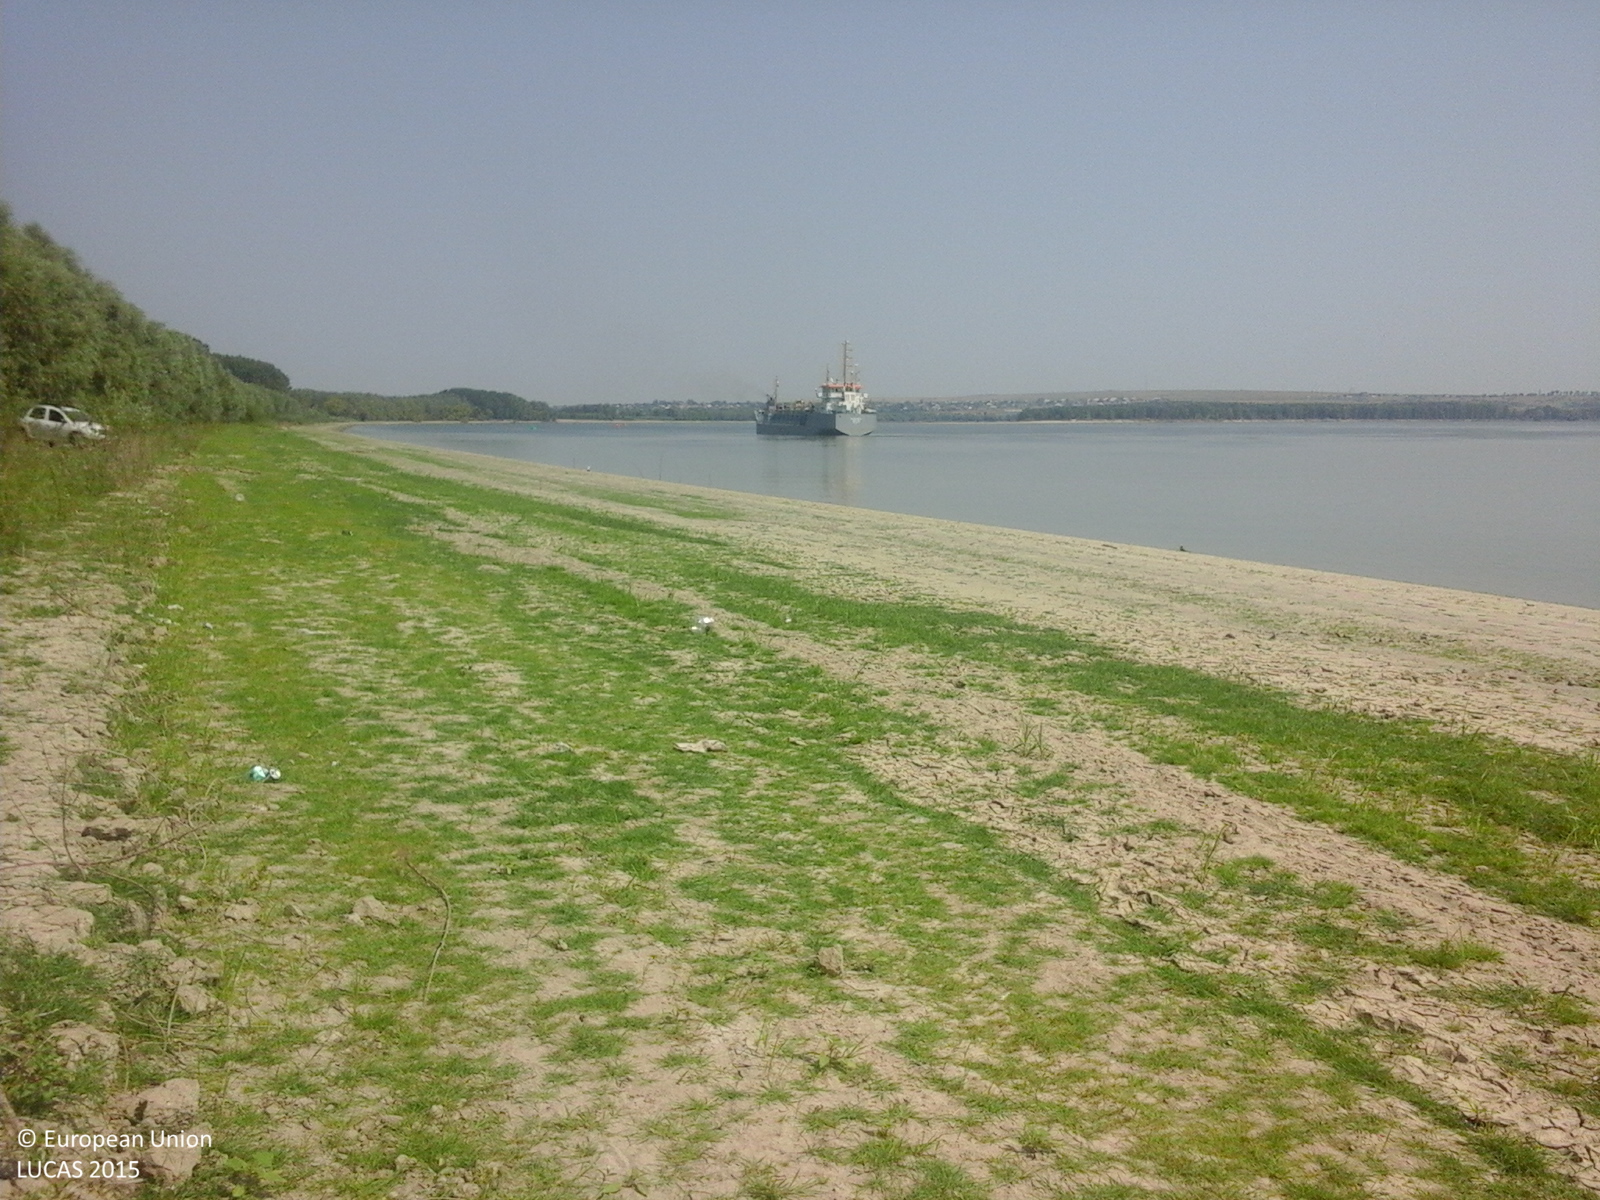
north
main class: Woodland
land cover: Broadleaved woodland
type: mire and swamp forests
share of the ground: > 75 %
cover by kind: broadleaved forest trees 100 %
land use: Semi-natural and natural areas not in use
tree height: > 5 m
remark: Temporary dry
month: July
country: RO
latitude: 45.4390
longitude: 28.1867
